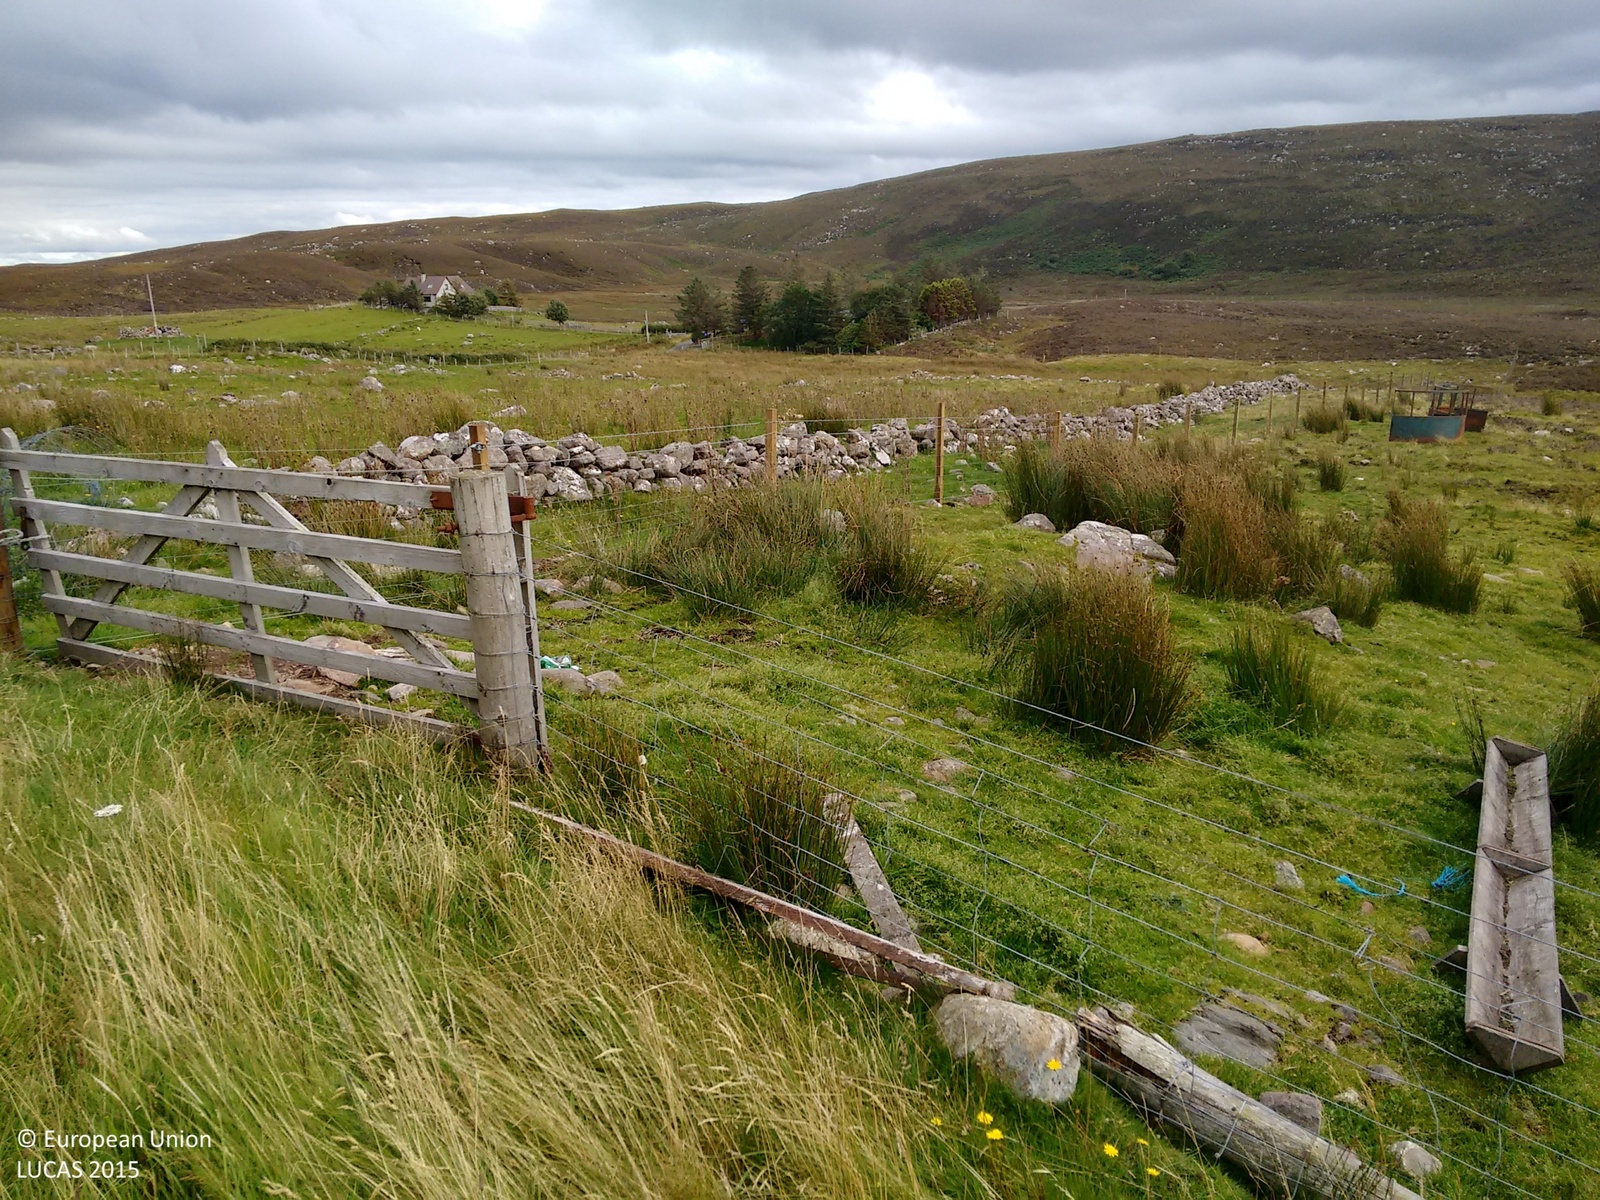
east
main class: Shrubland
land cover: Shrubland without tree cover
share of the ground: > 75 %
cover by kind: shrubs 80 %, herbaceous plants 20 %
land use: Agriculture (excluding fallow land and kitchen gardens)
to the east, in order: Shrubland without tree cover
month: September
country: GB
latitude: 57.8377
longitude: -5.5597
